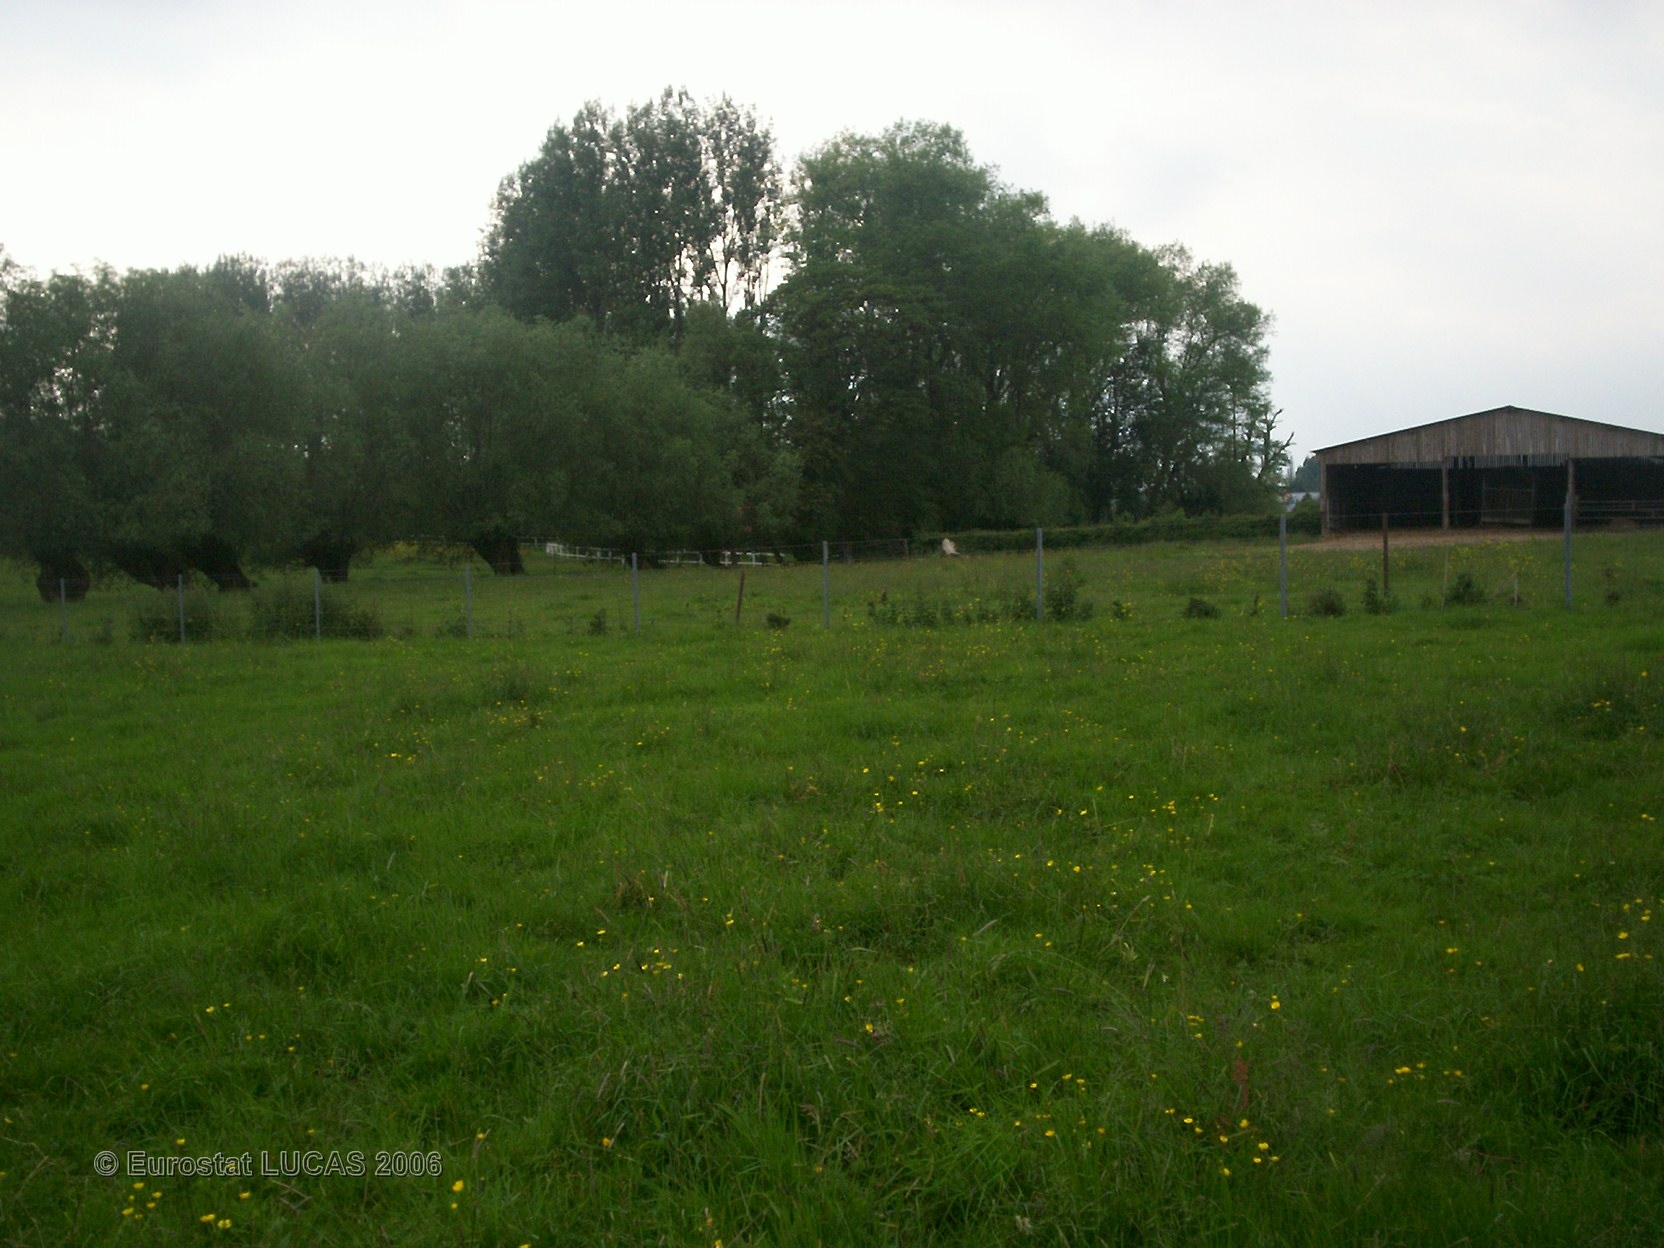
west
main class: Grassland
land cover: Grassland without tree/shrub cover
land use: Agriculture (excluding fallow land and kitchen gardens)
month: June
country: FR
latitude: 50.3160
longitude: 3.6875
